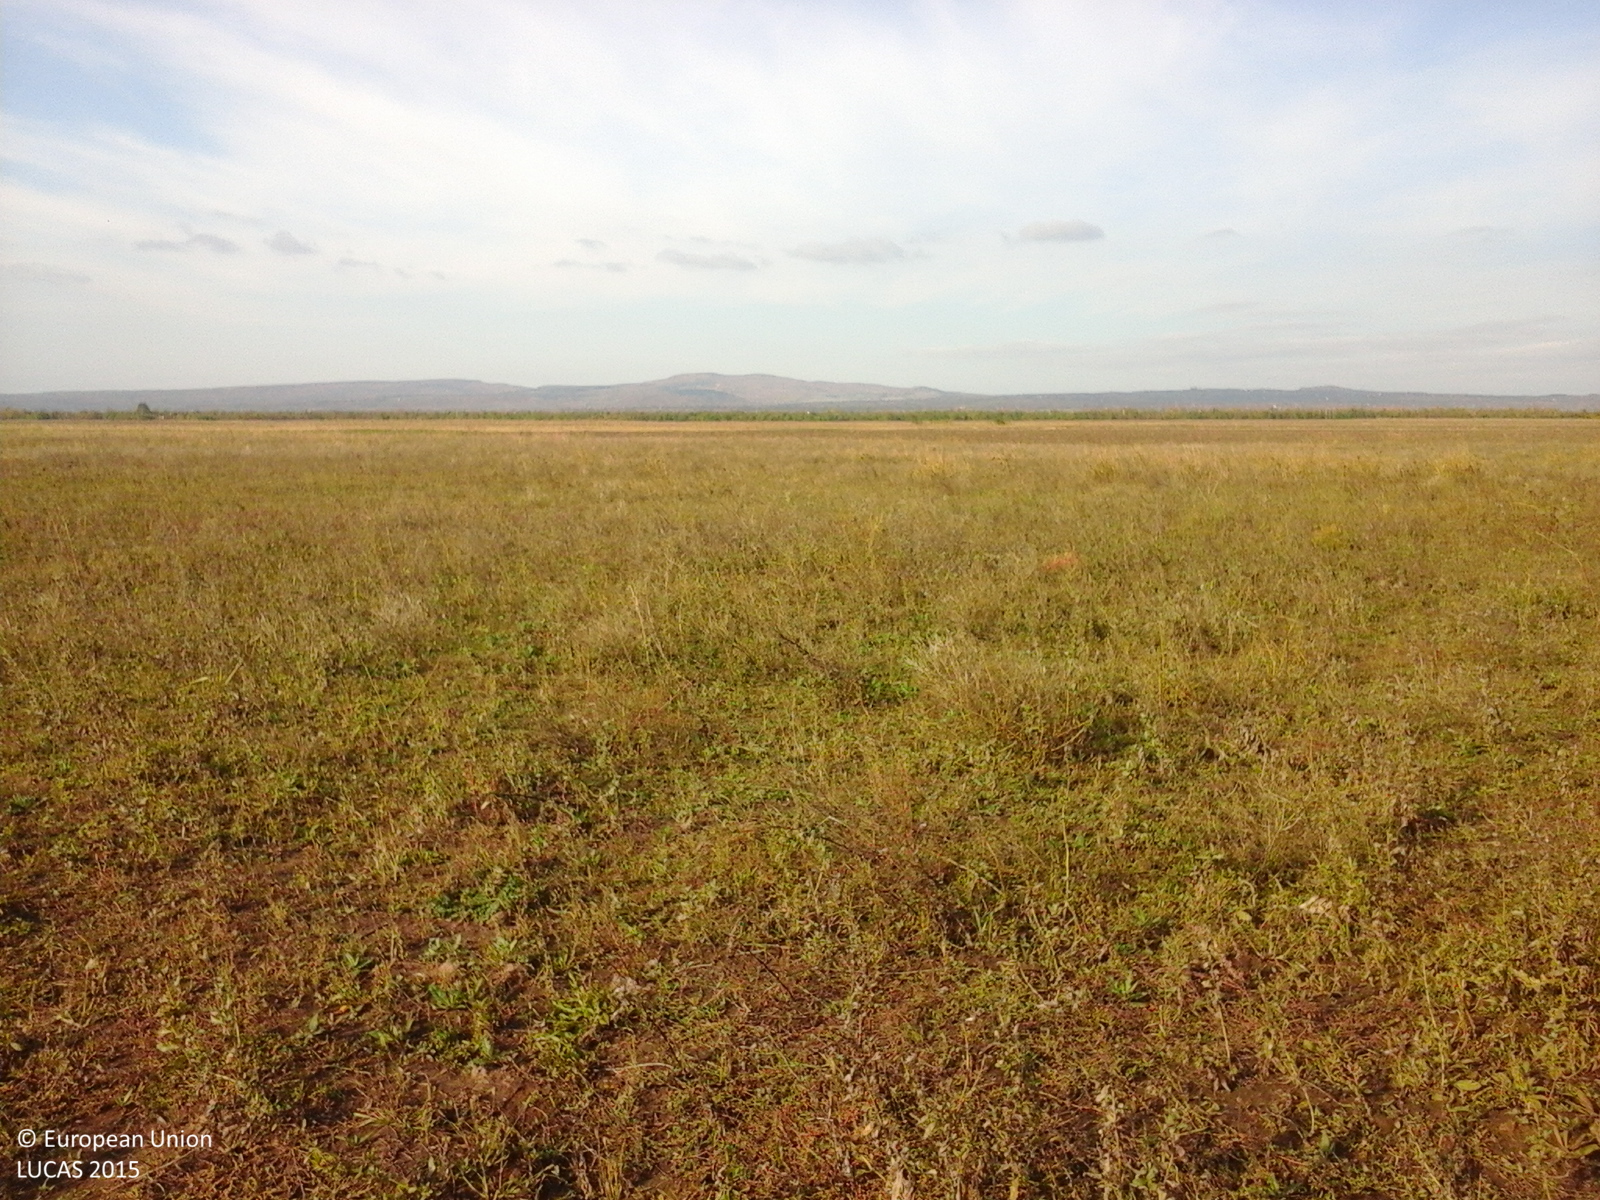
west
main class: Grassland
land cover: Spontaneously vegetated surfaces
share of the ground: > 75 %
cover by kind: herbaceous plants 100 %
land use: Fallow land
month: October
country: RO
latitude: 45.5258
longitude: 27.1333
